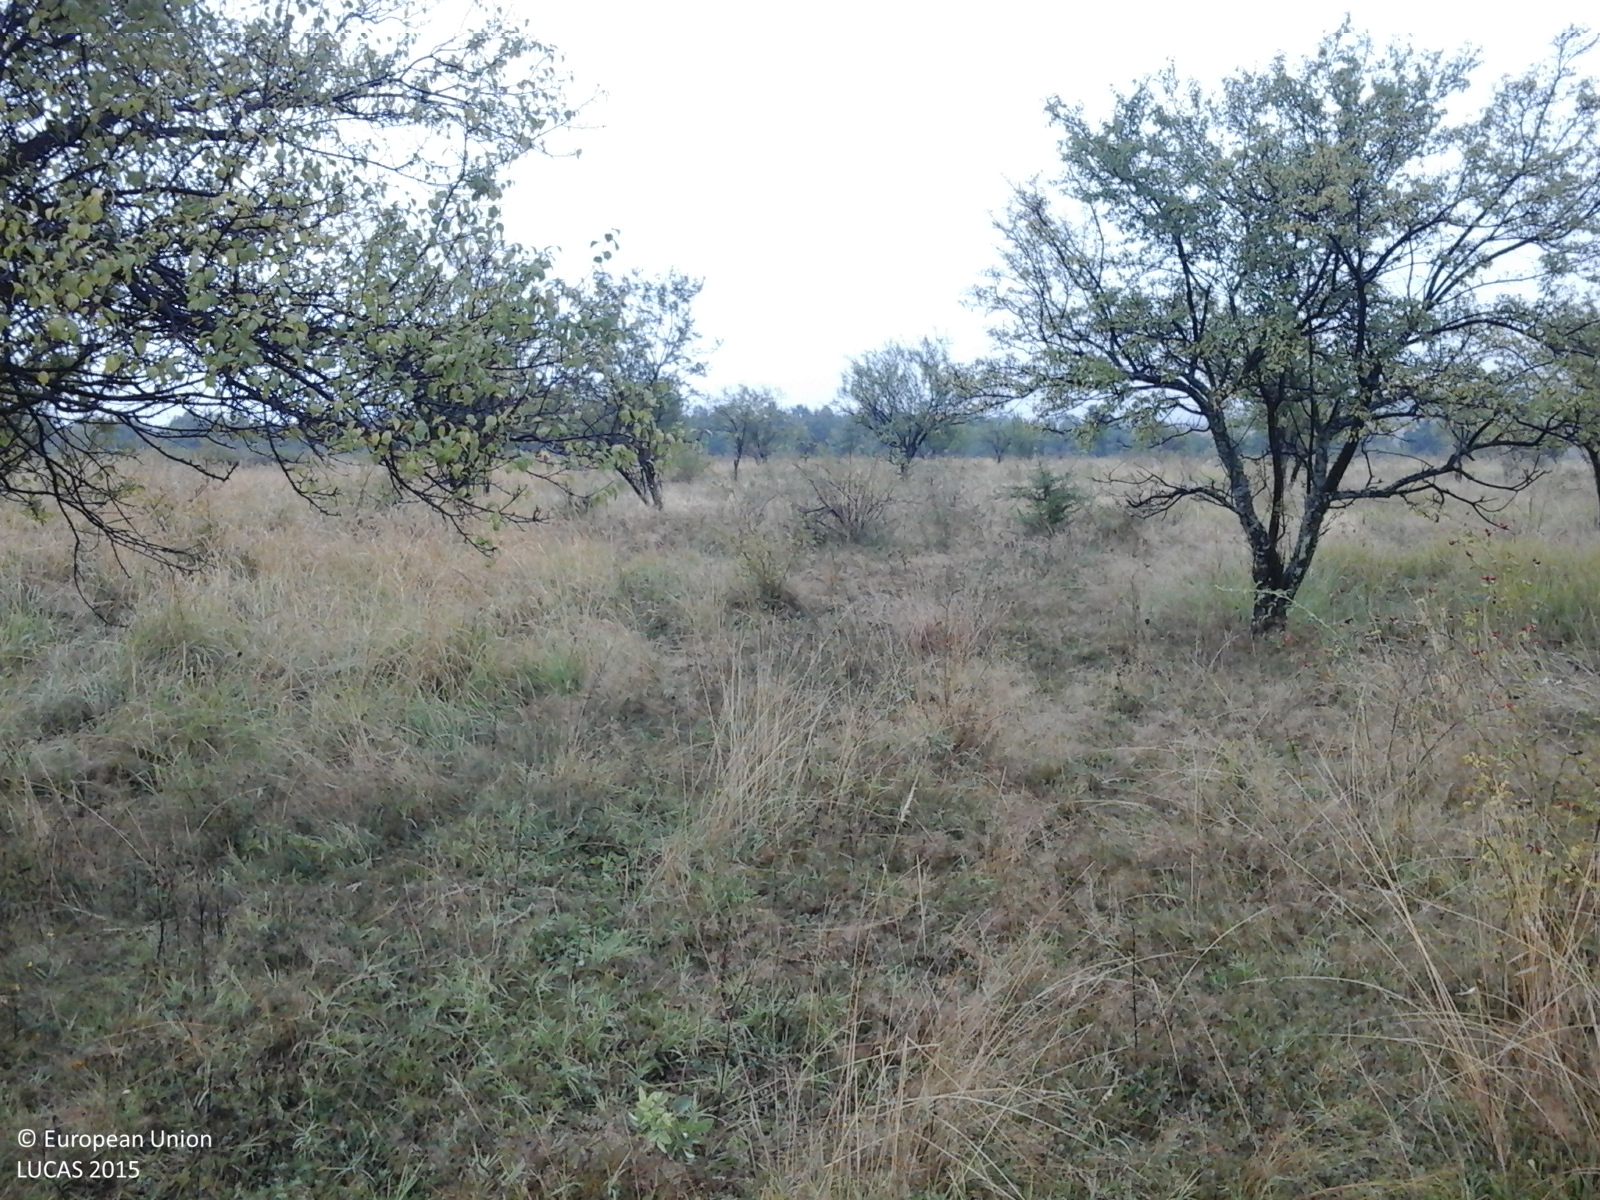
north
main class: Cropland
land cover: Apple fruit
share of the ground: 50 - 75 %
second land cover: Grassland without tree/shrub cover
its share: > 75 %
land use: Agriculture (excluding fallow land and kitchen gardens)
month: September
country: RO
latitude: 45.0809
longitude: 23.5631
